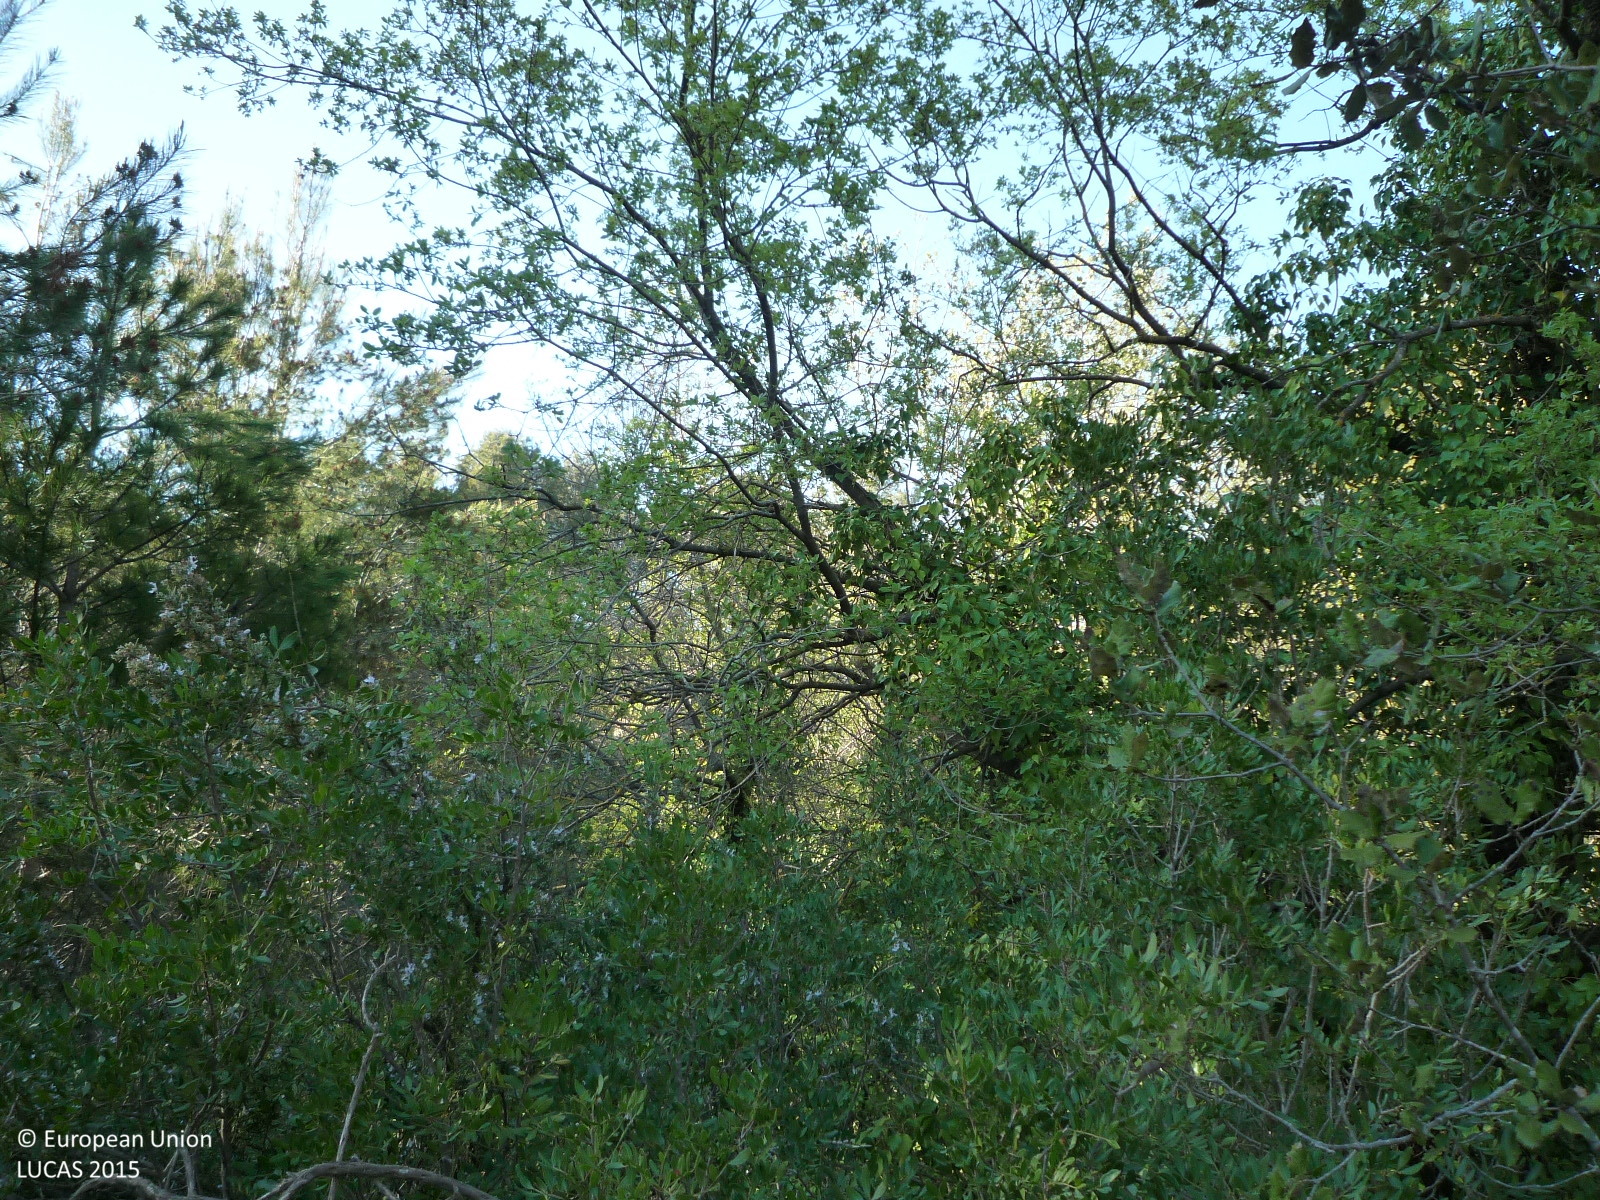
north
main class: Woodland
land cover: Pine dominated mixed woodland
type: coniferous forest of the mediterranean region
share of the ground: > 75 %
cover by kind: coniferous forest trees 55 %, broadleaved forest trees 30 %, shrubs 15 %
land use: Semi-natural and natural areas not in use
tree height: > 5 m
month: April
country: ES
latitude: 41.4195
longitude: 1.6535
